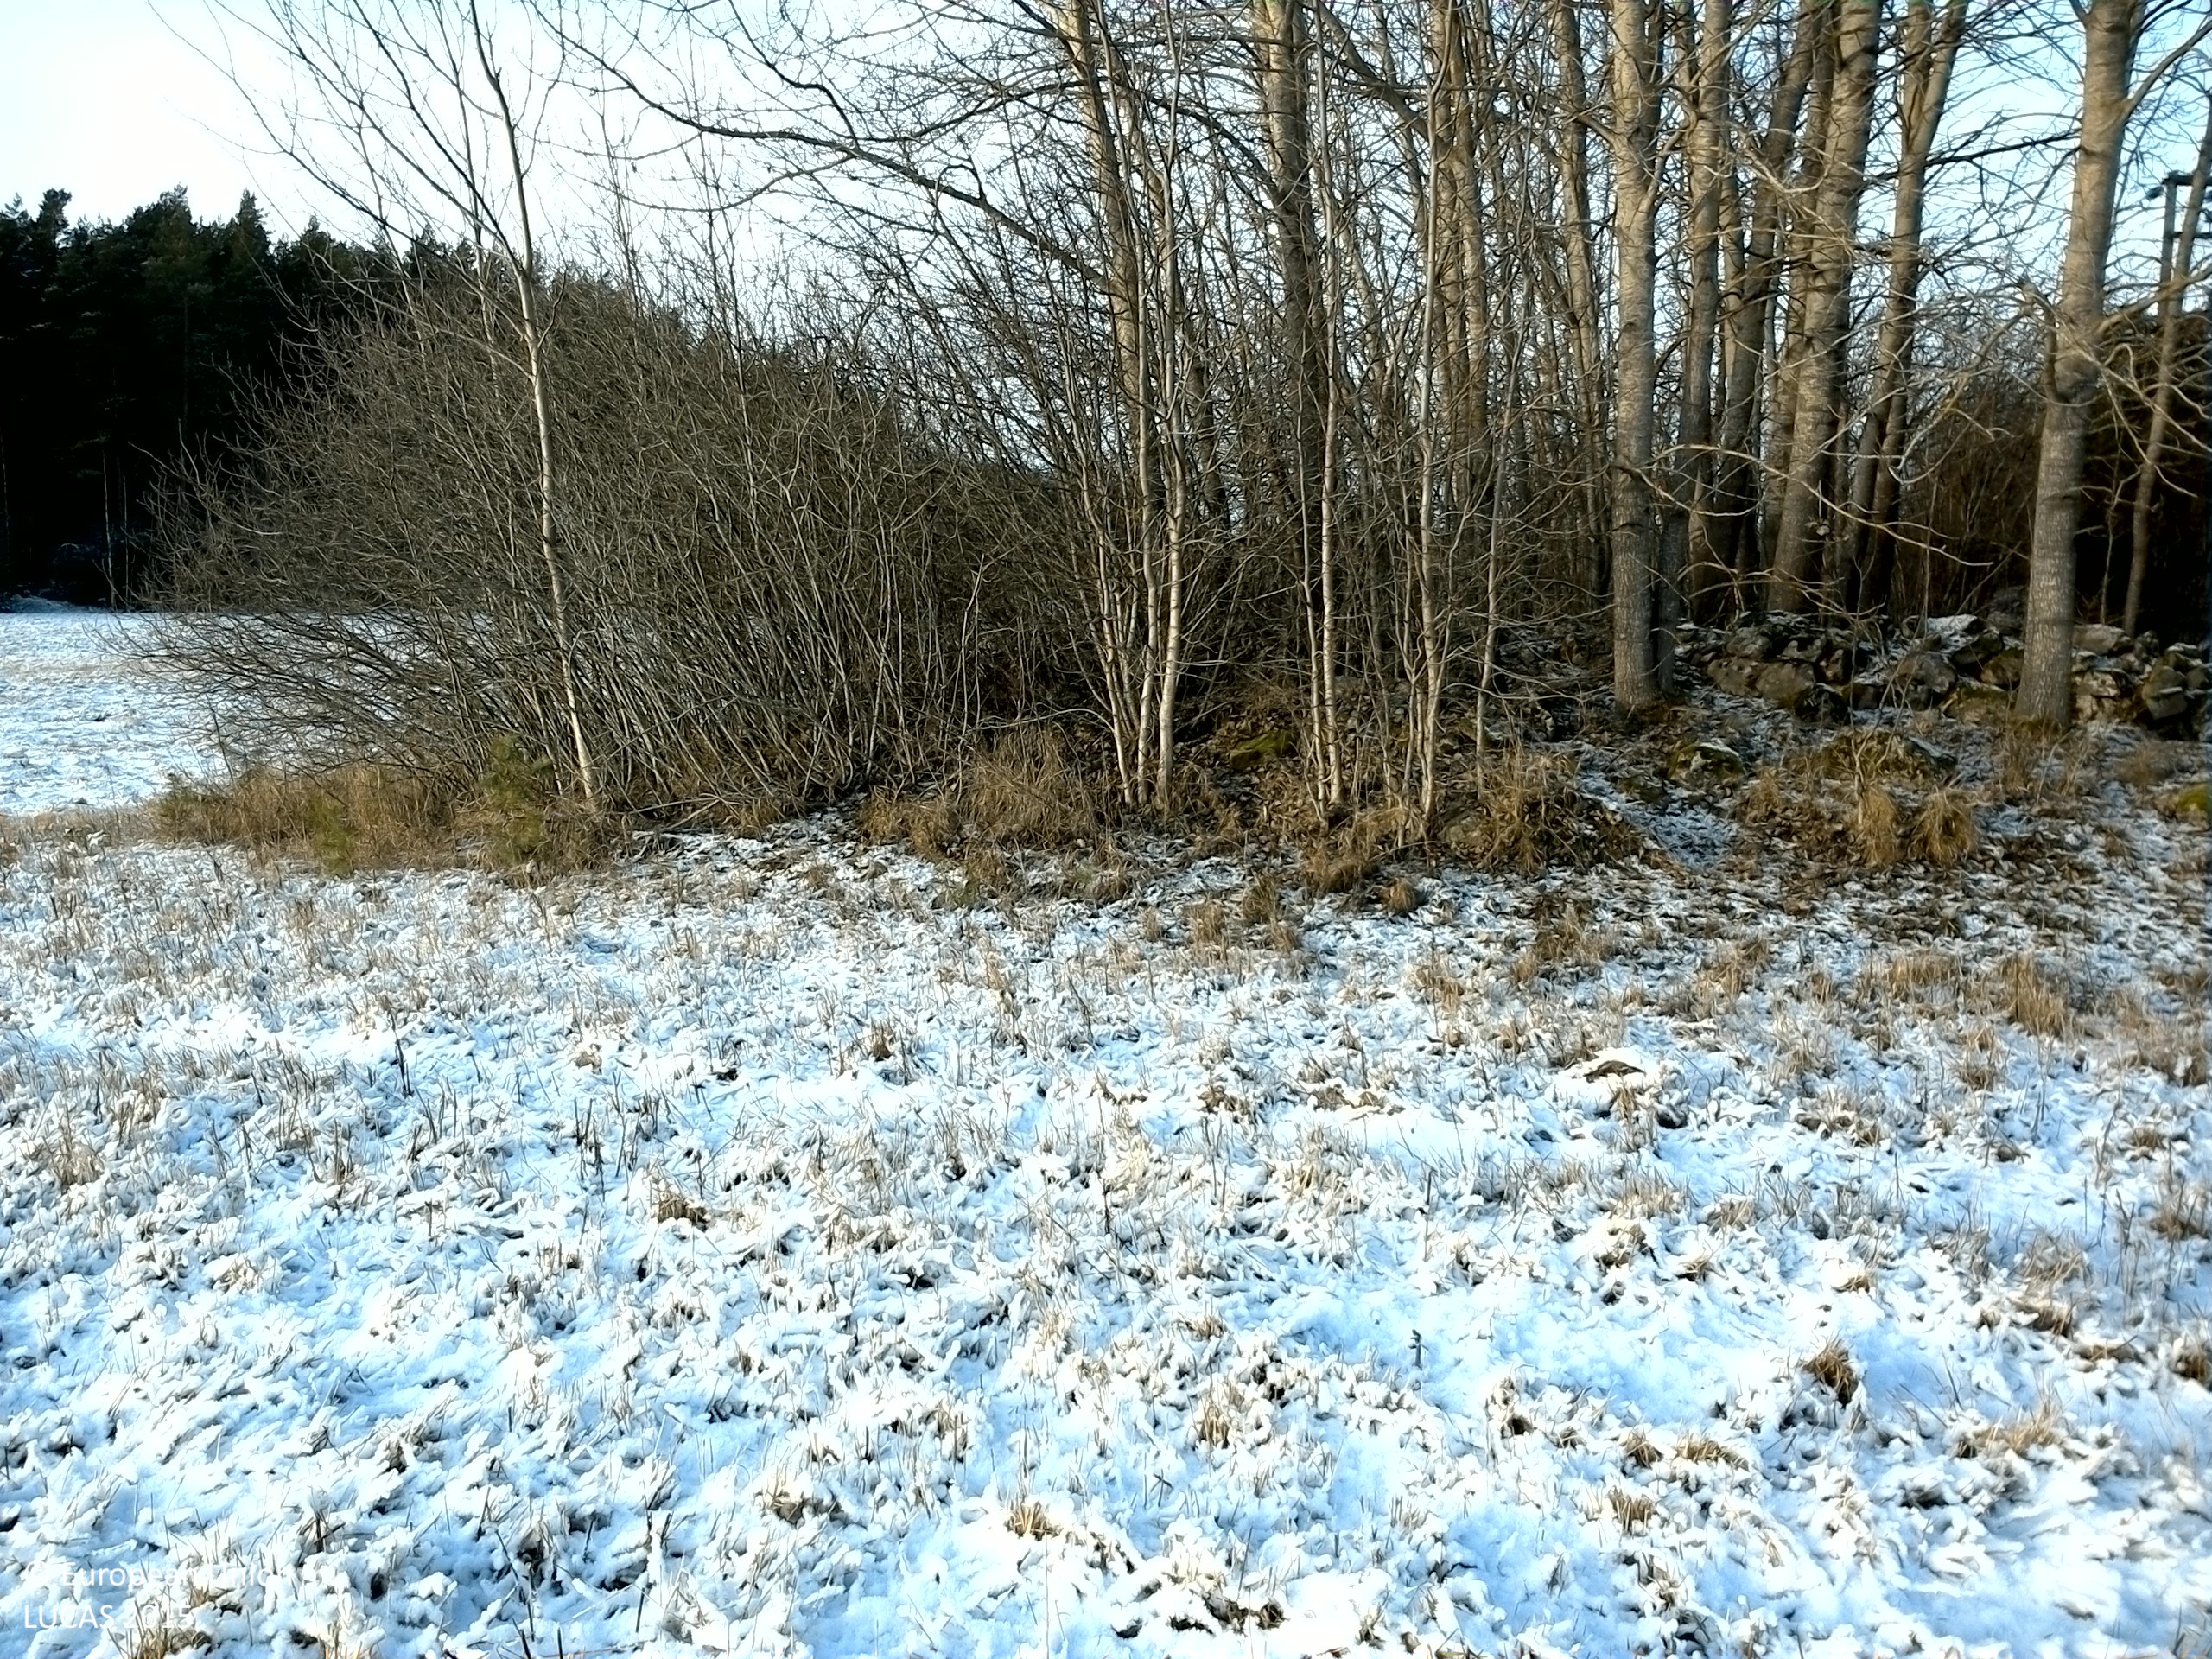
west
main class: Grassland
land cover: Grassland without tree/shrub cover
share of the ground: > 75 %
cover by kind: herbaceous plants 100 %
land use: Agriculture (excluding fallow land and kitchen gardens)
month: December
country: SE
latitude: 59.5666
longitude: 16.3814
